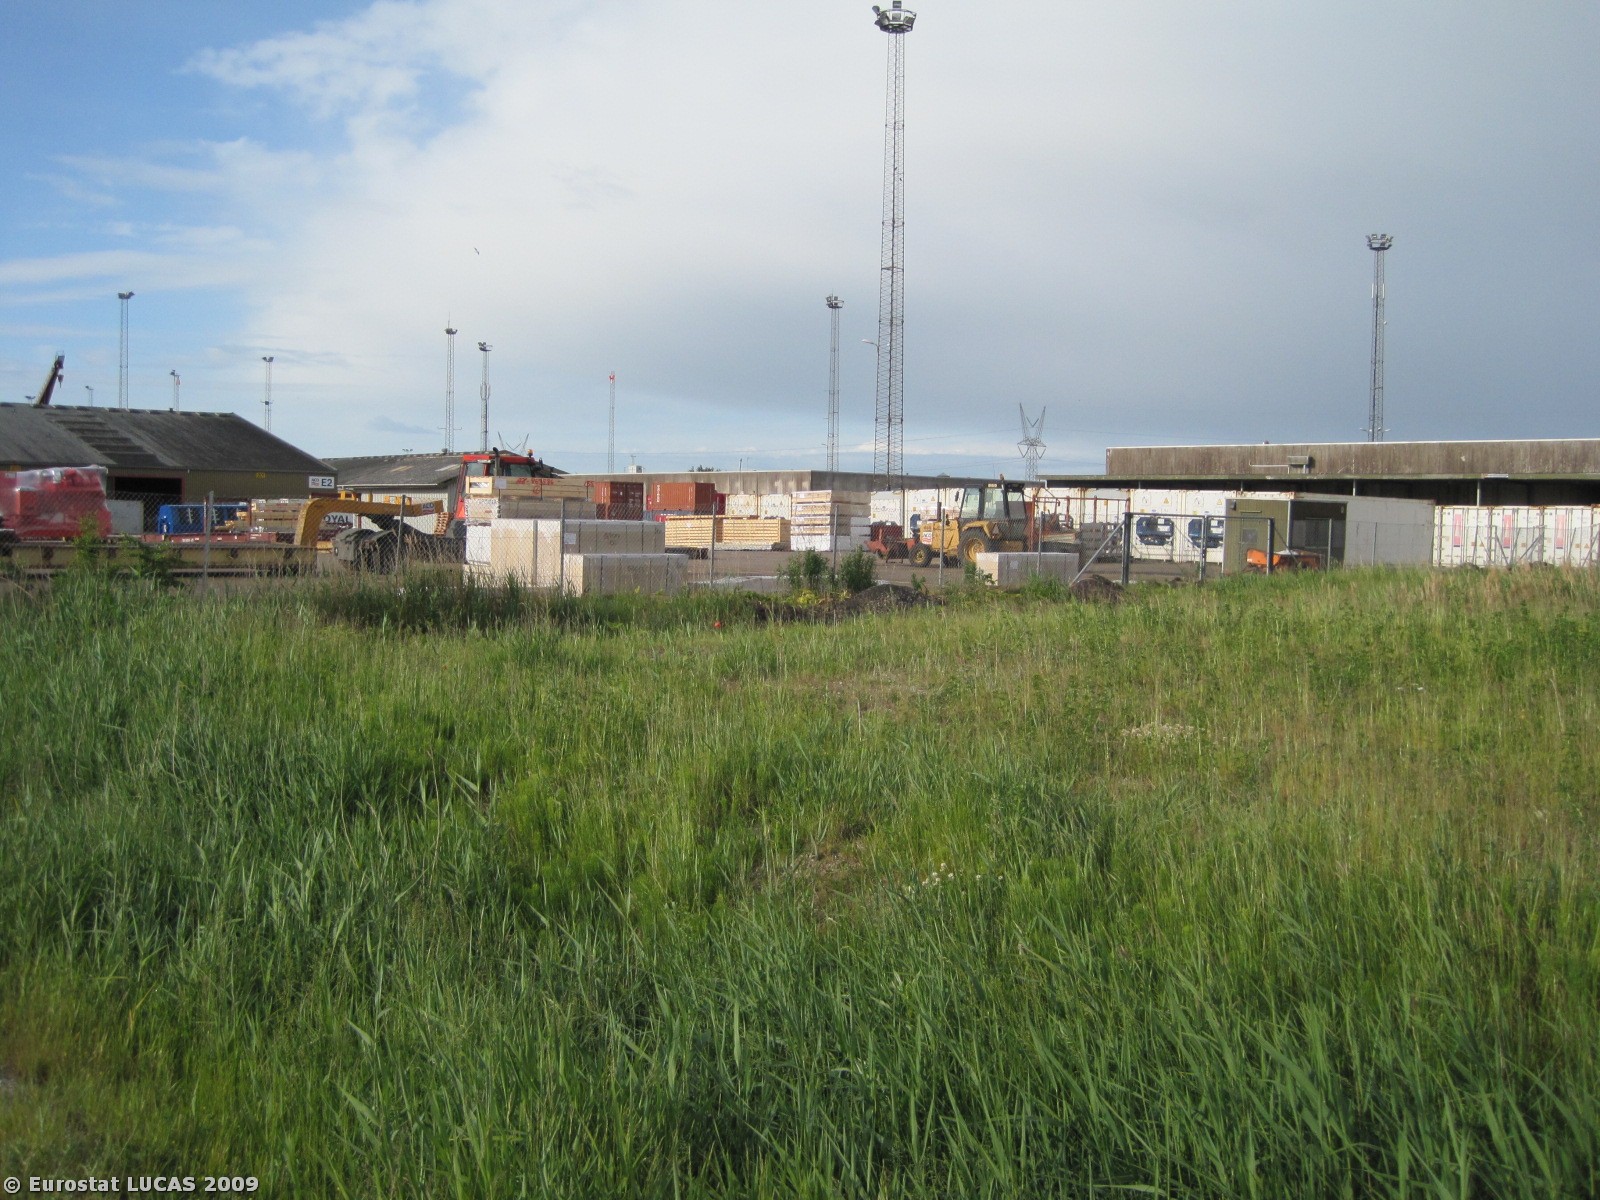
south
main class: Grassland
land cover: Grassland without tree/shrub cover
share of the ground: > 75 %
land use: Unused
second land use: Manufacturing of food, beverages and tobacco products
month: June
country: DK
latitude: 57.0506
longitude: 10.0494
